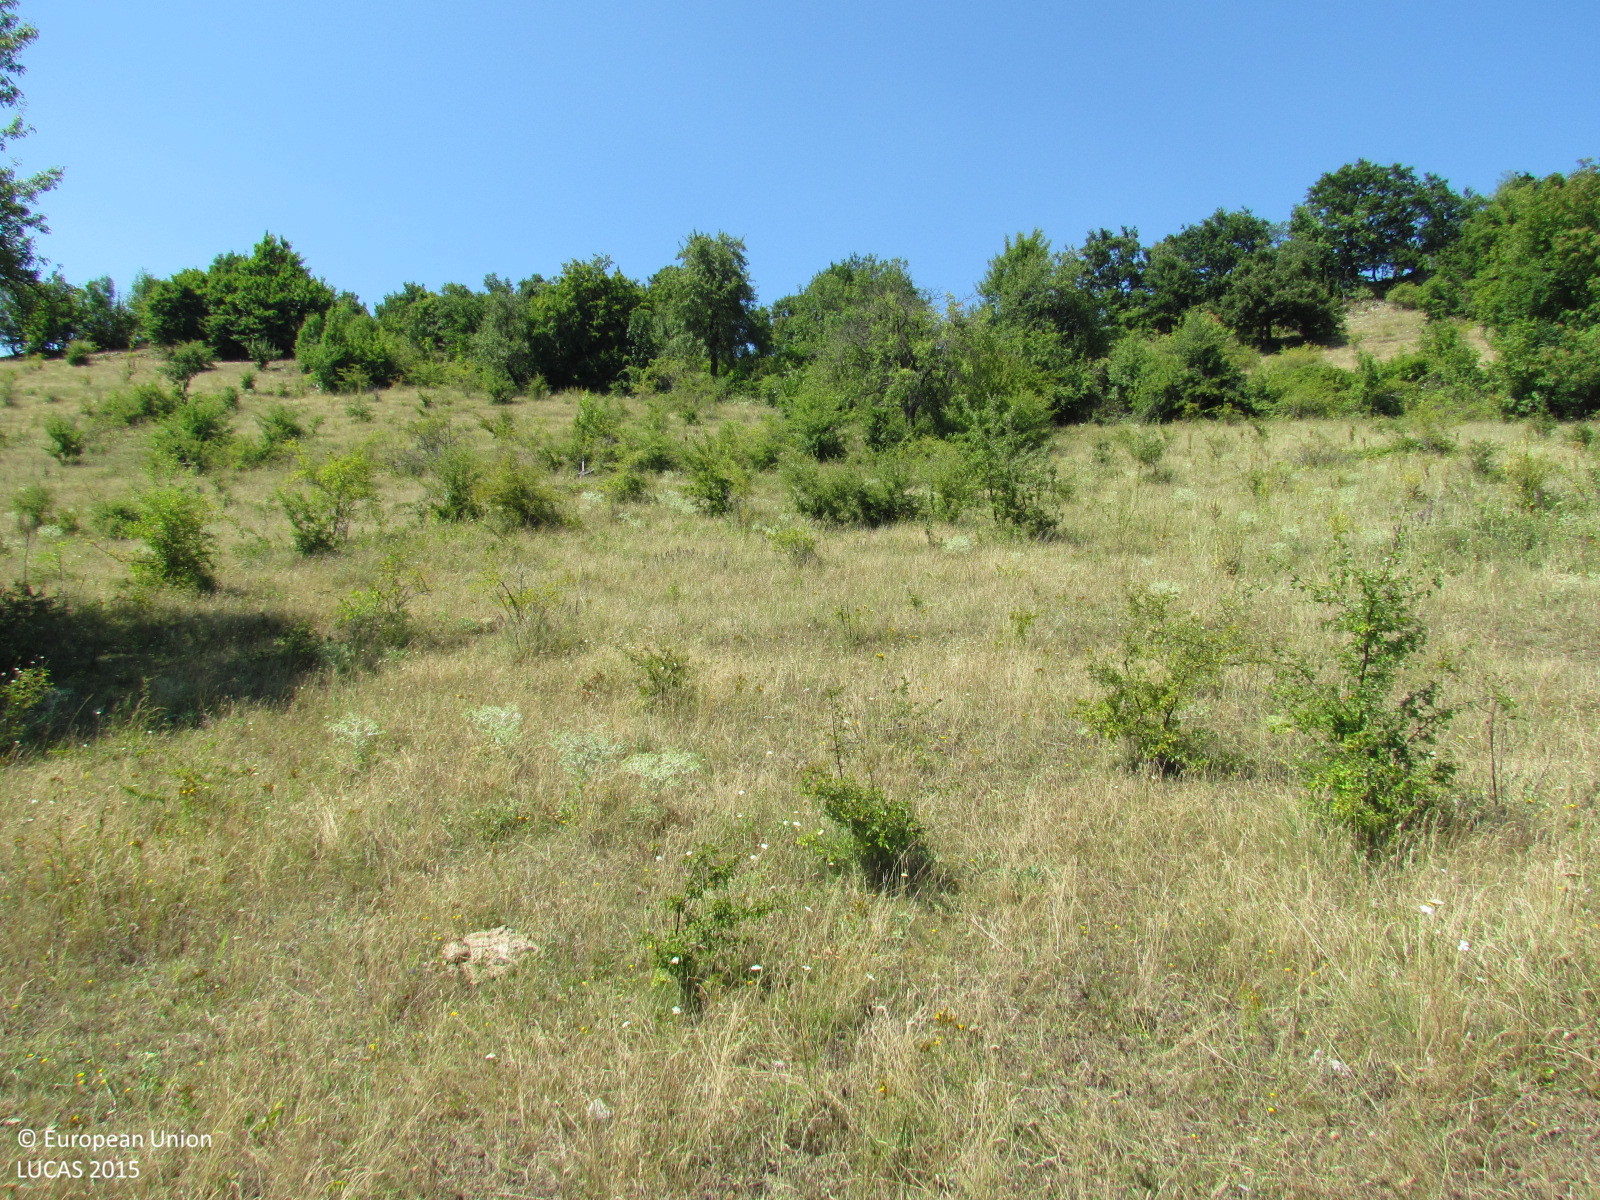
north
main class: Grassland
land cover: Grassland with sparse tree/shrub cover
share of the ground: > 75 %
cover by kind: herbaceous plants 85 %, shrubs 10 %, broadleaved forest trees 5 %
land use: Agriculture (excluding fallow land and kitchen gardens)
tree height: > 5 m
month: July
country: BG
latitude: 42.8773
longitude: 27.4444
